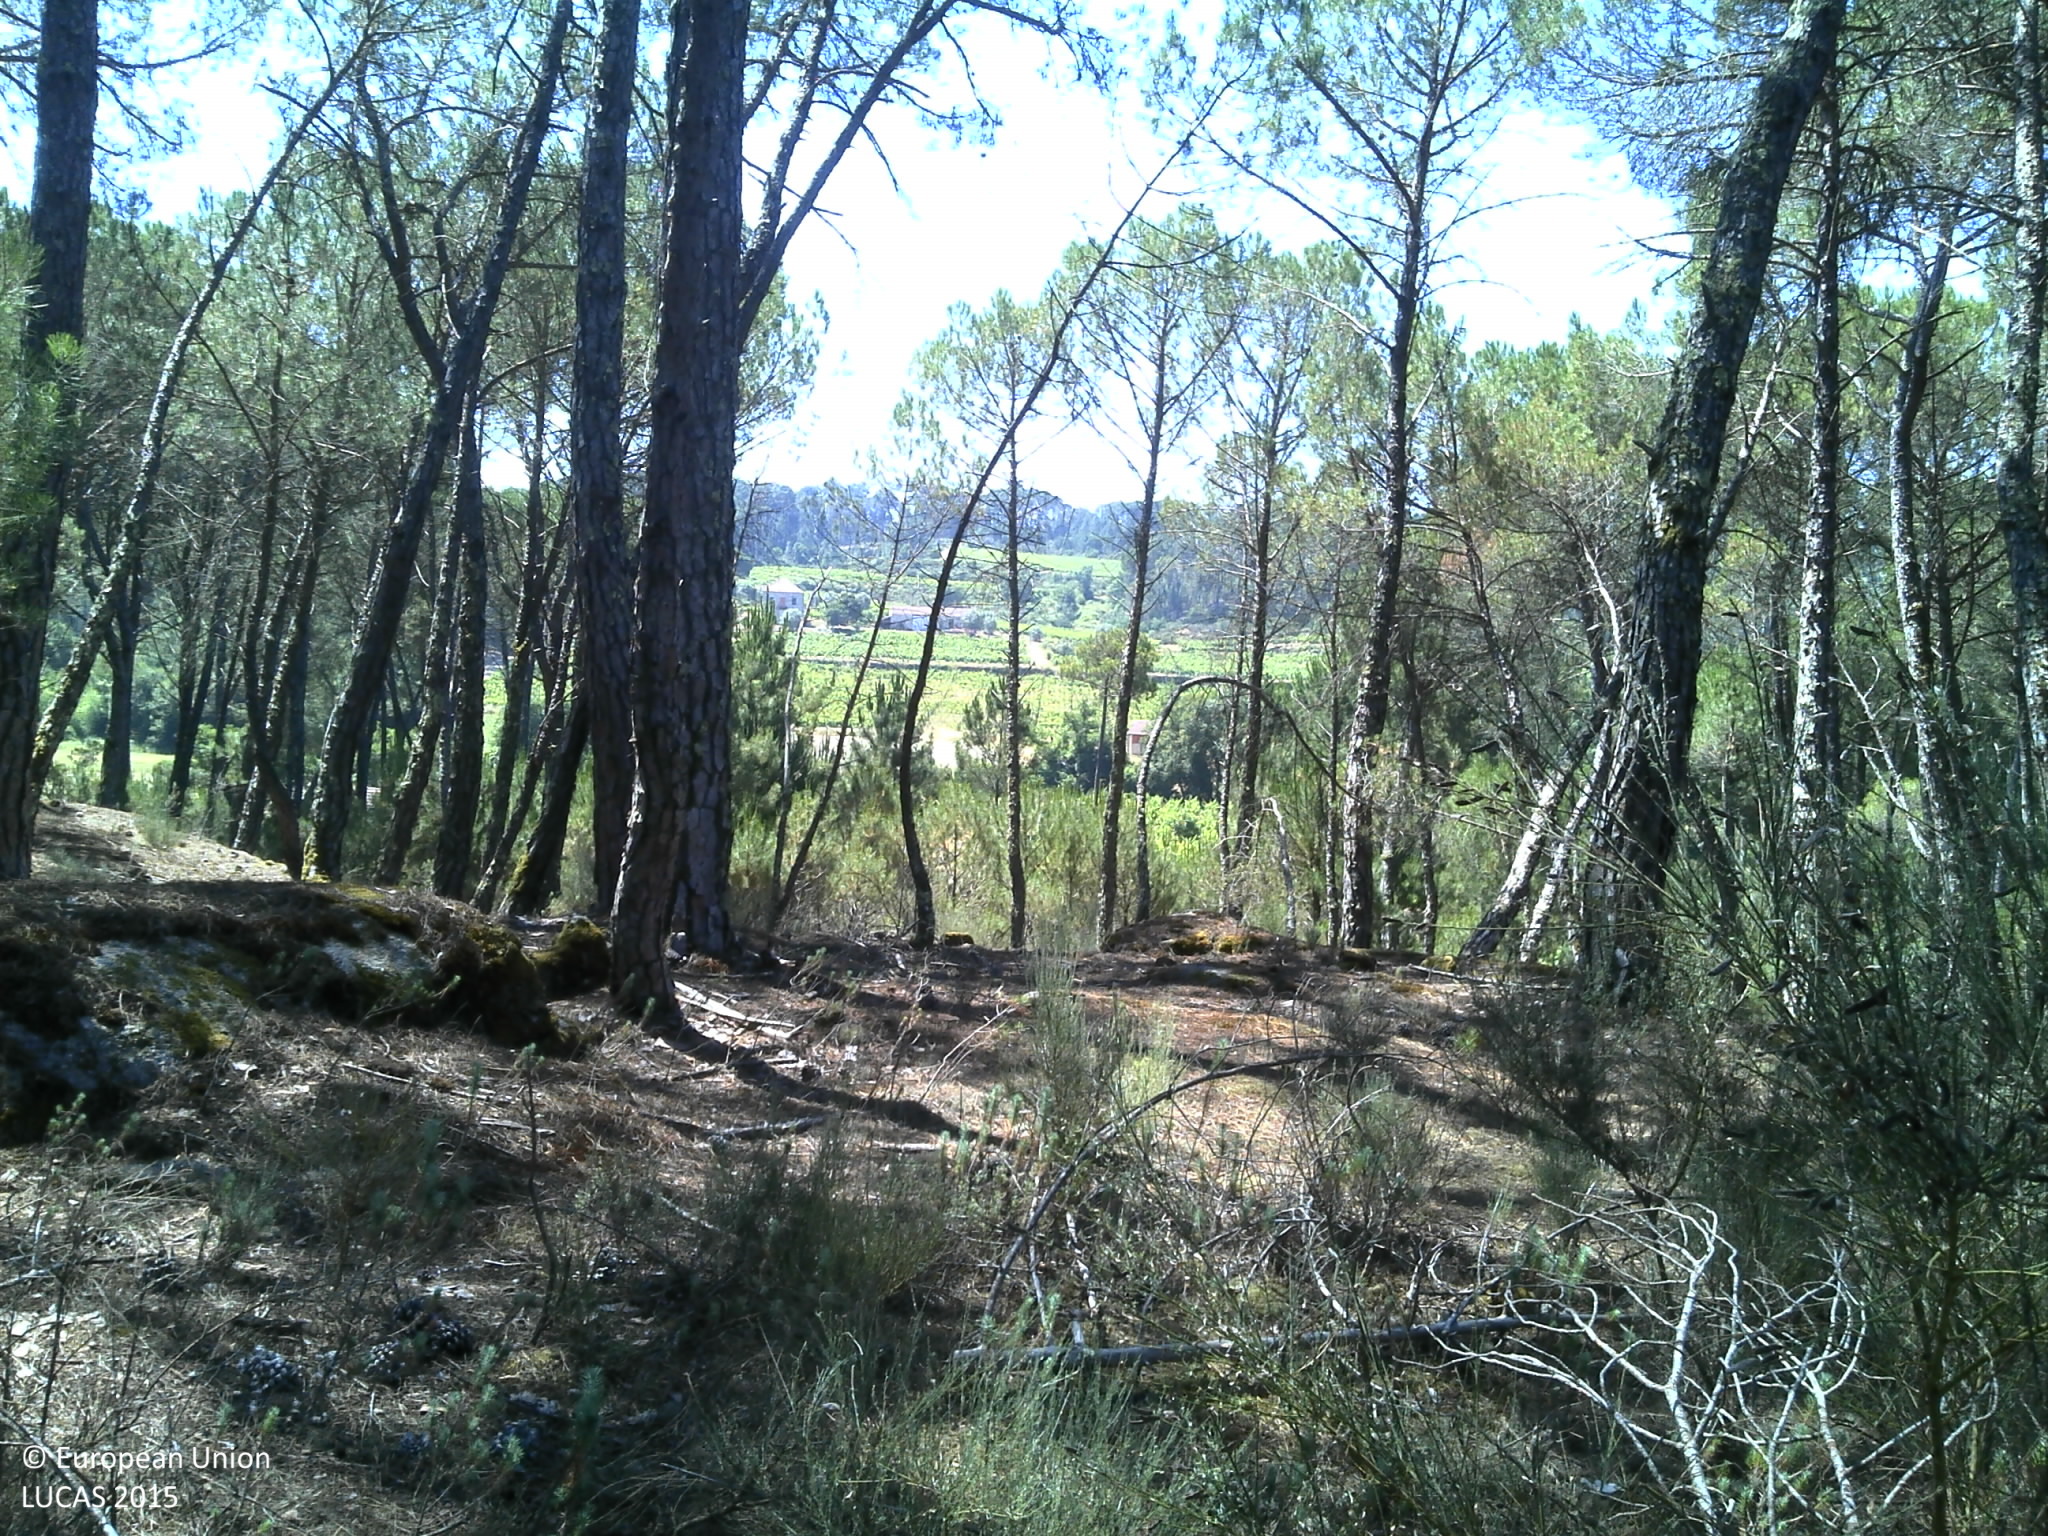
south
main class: Woodland
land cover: Pine dominated coniferous woodland
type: coniferous forest of the mediterranean region
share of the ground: 50 - 75 %
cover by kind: coniferous forest trees 70 %, shrubs 25 %, herbaceous plants 5 %
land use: Forestry
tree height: > 5 m
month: June
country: PT
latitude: 40.5729
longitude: -7.8520
